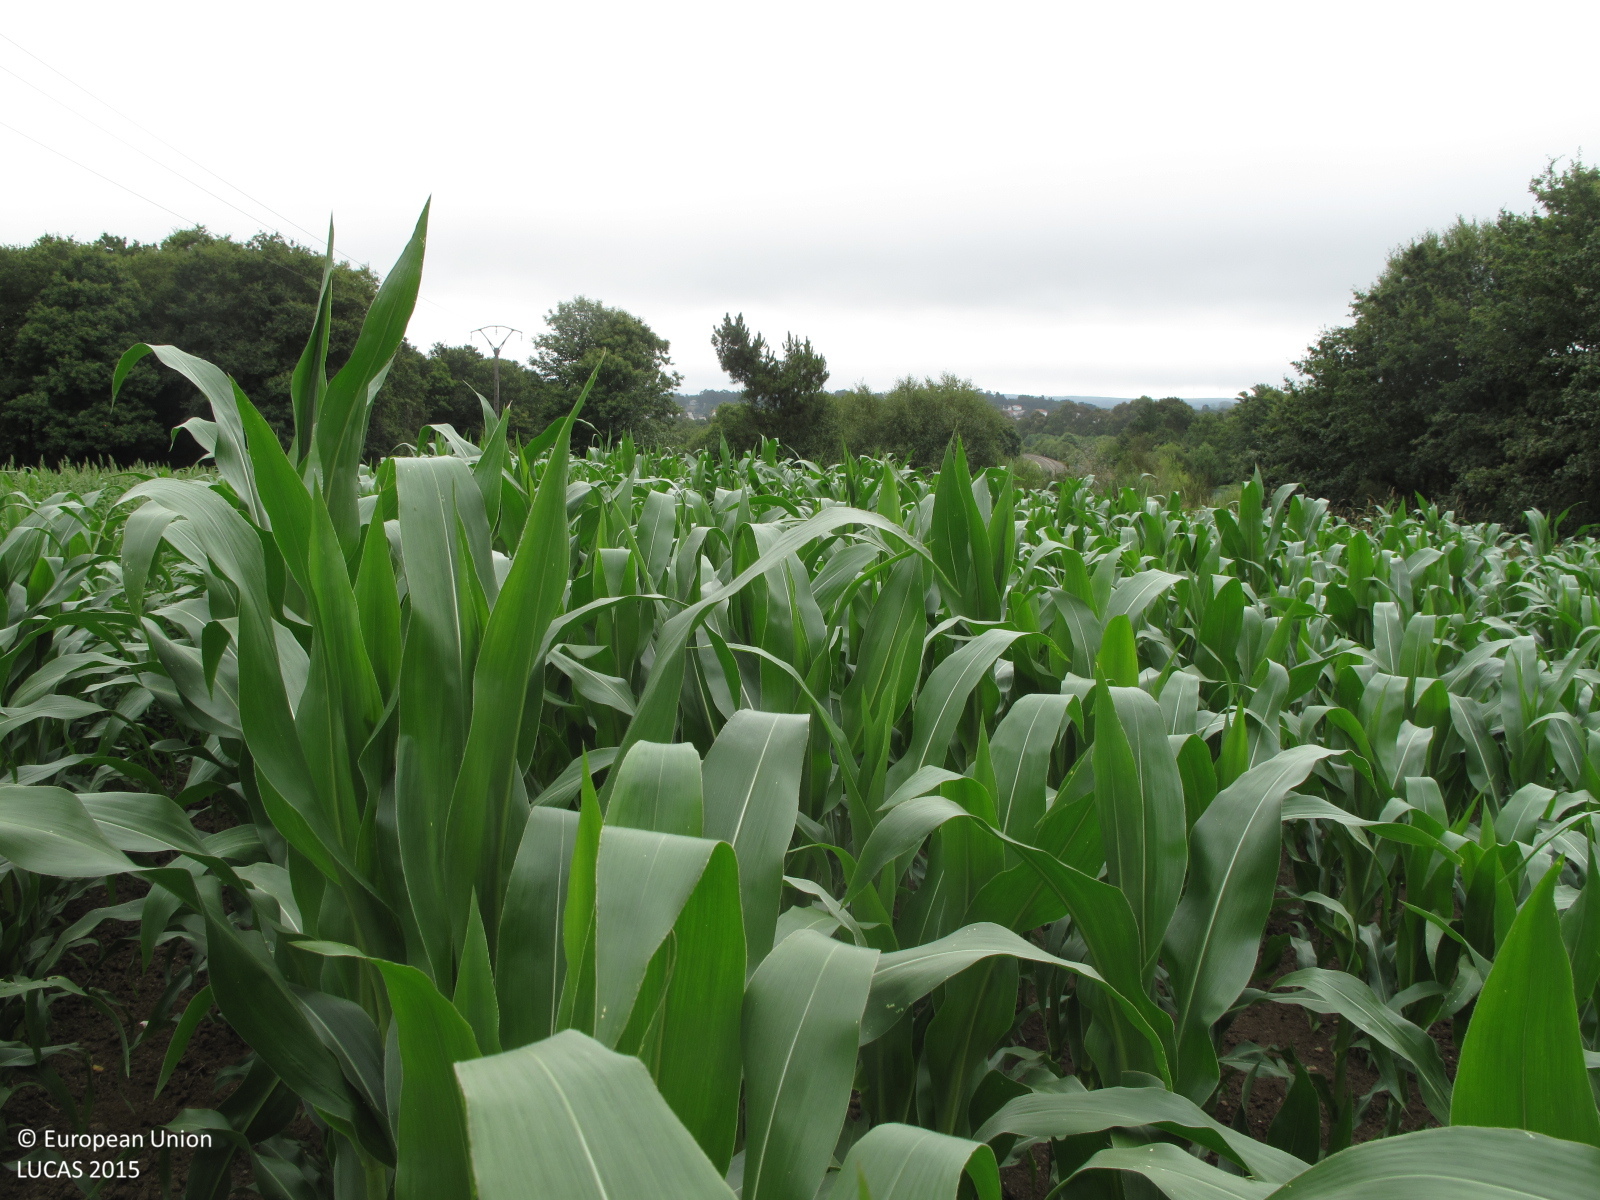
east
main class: Cropland
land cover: Maize
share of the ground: > 75 %
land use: Agriculture (excluding fallow land and kitchen gardens)
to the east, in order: Maize; Broadleaved woodland; Common wheat; Electric lines; Common wheat; Shrubland with sparse tree cover; Broadleaved woodland
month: July
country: ES
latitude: 43.1380
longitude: -8.0552
